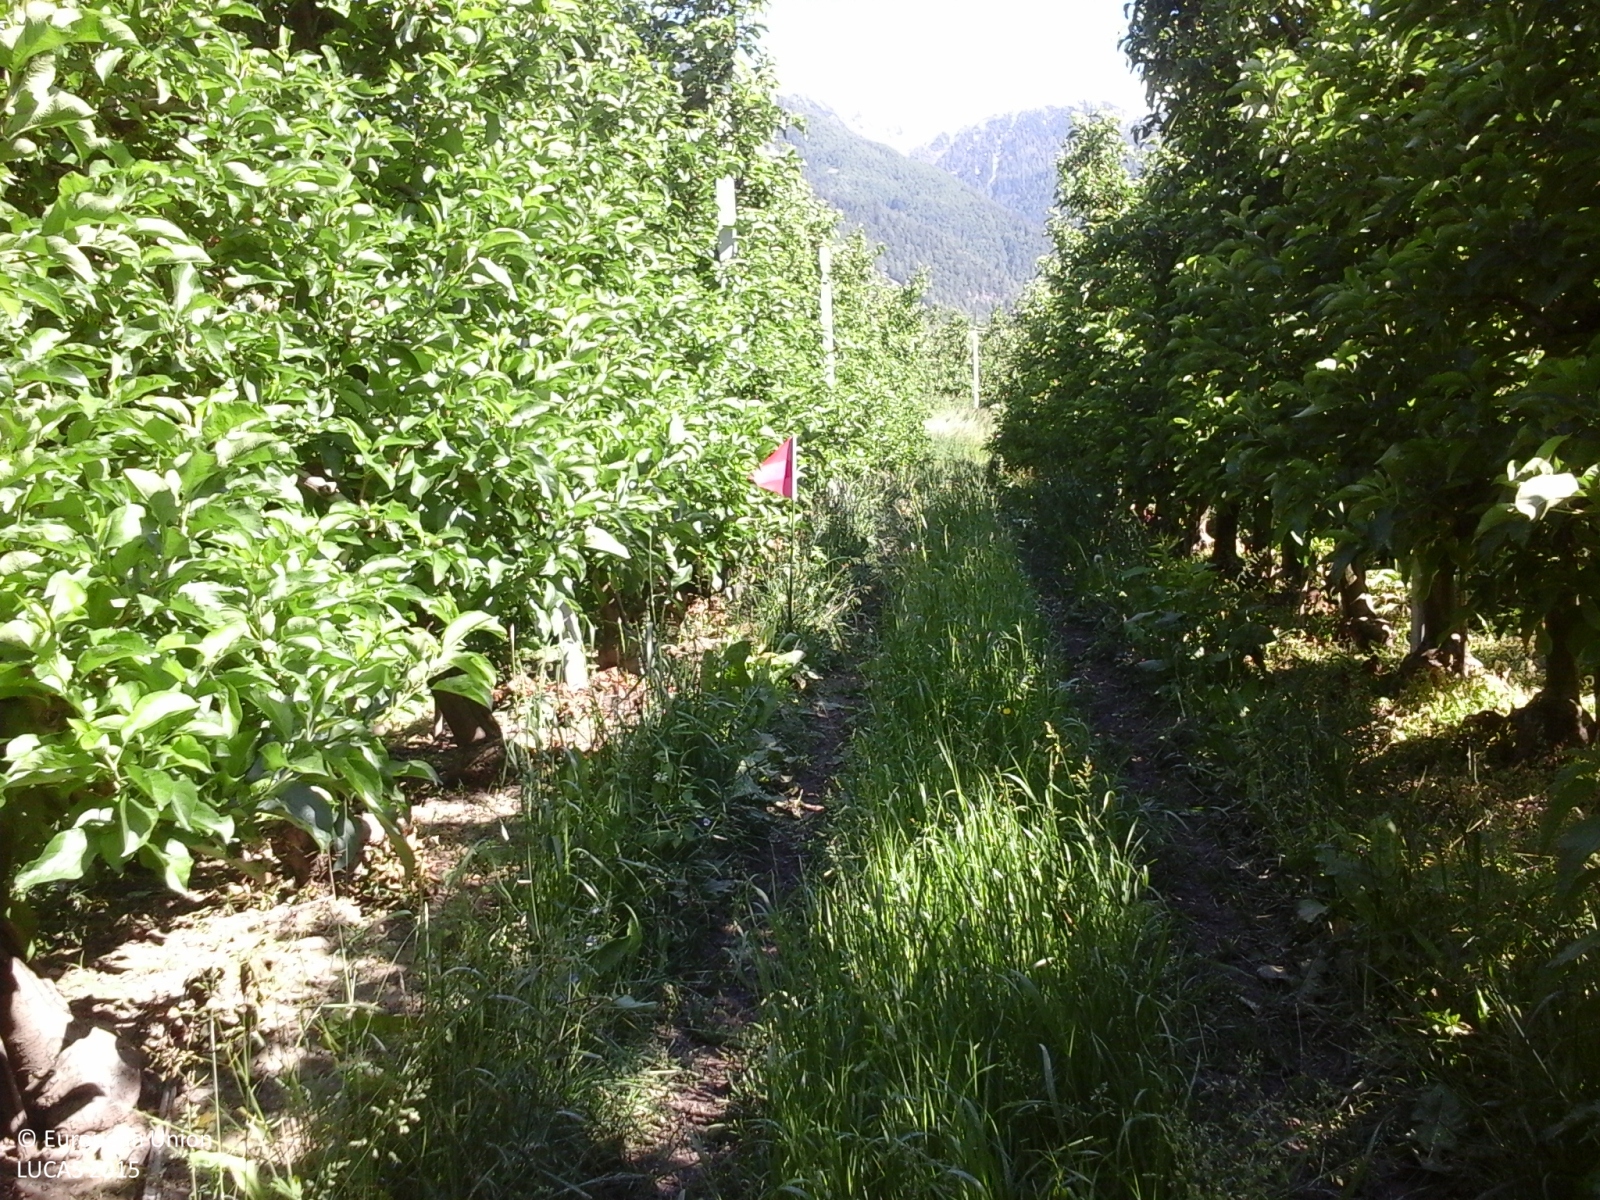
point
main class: Cropland
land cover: Apple fruit
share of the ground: > 75 %
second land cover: Grassland without tree/shrub cover
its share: > 75 %
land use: Agriculture (excluding fallow land and kitchen gardens)
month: May
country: IT
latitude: 46.6178
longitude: 10.8739
